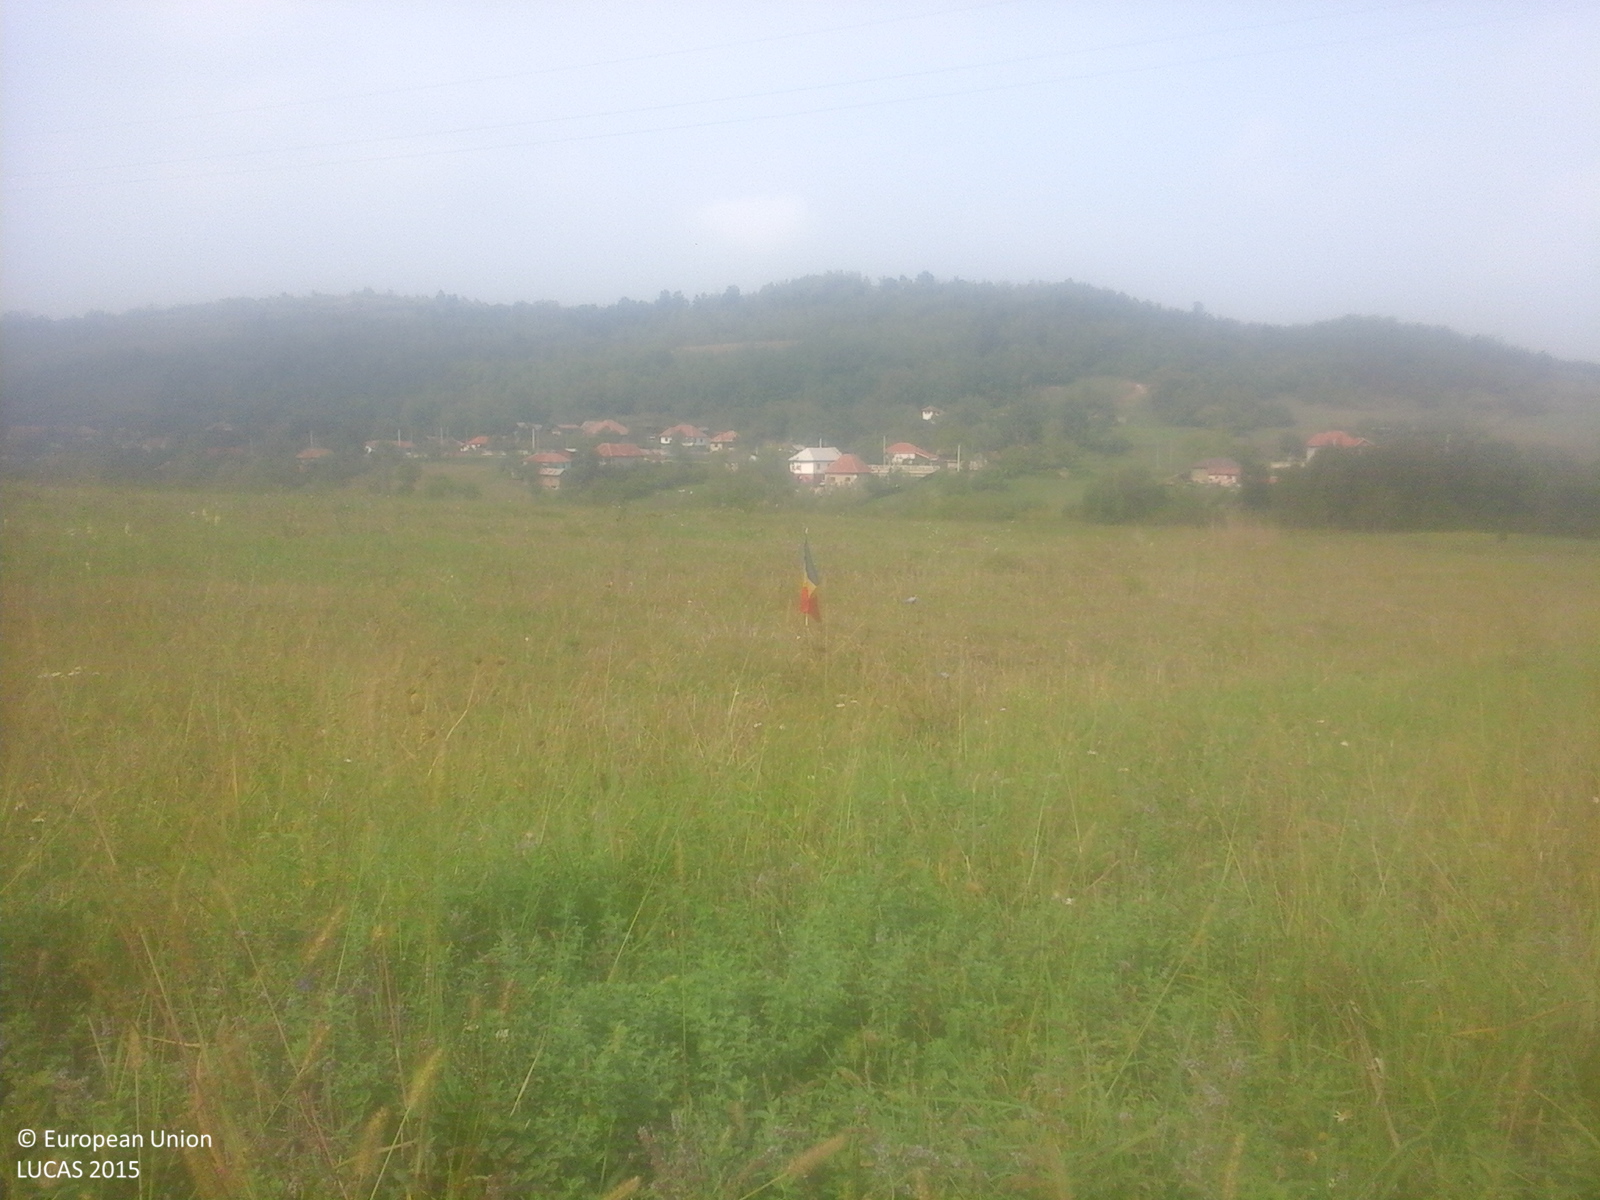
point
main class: Cropland
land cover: Temporary grasslands
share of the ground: > 75 %
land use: Agriculture (excluding fallow land and kitchen gardens)
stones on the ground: < 10 %
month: September
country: RO
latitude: 44.7718
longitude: 23.1276
